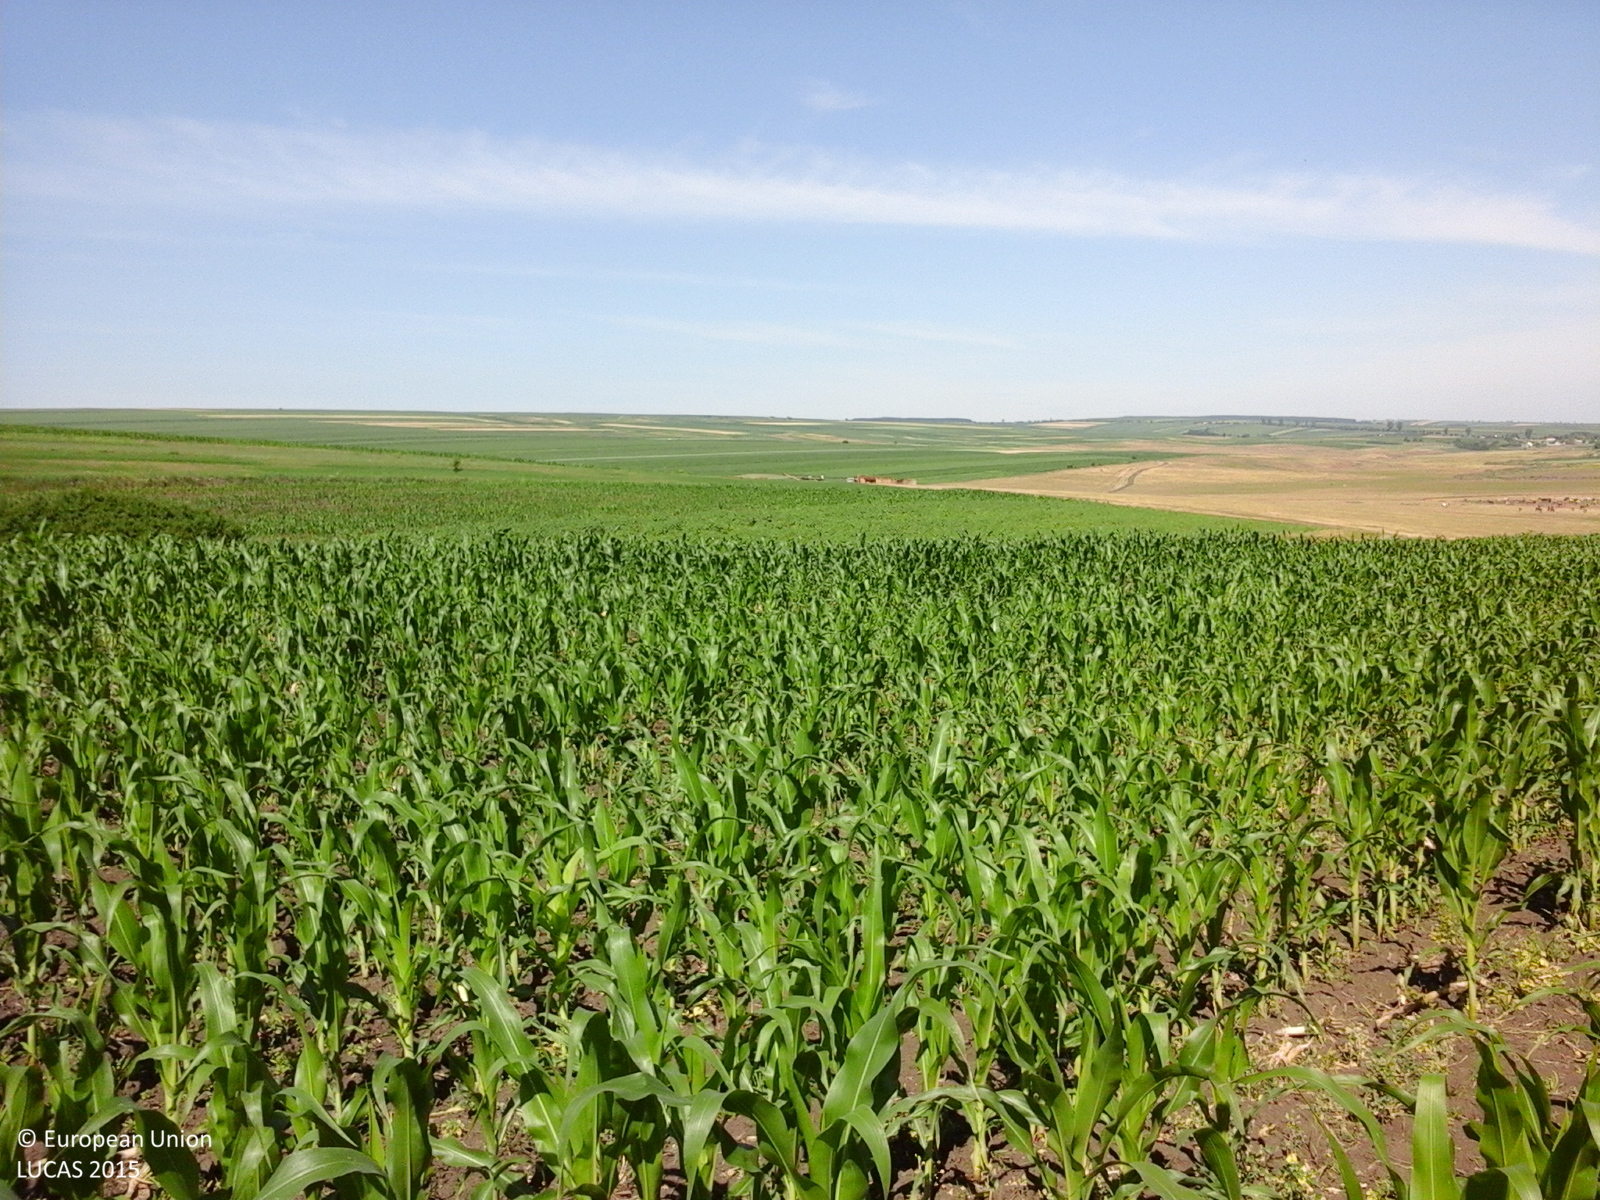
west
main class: Cropland
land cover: Maize
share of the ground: 50 - 75 %
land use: Agriculture (excluding fallow land and kitchen gardens)
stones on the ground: < 10 %
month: June
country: RO
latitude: 47.9843
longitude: 27.0572
